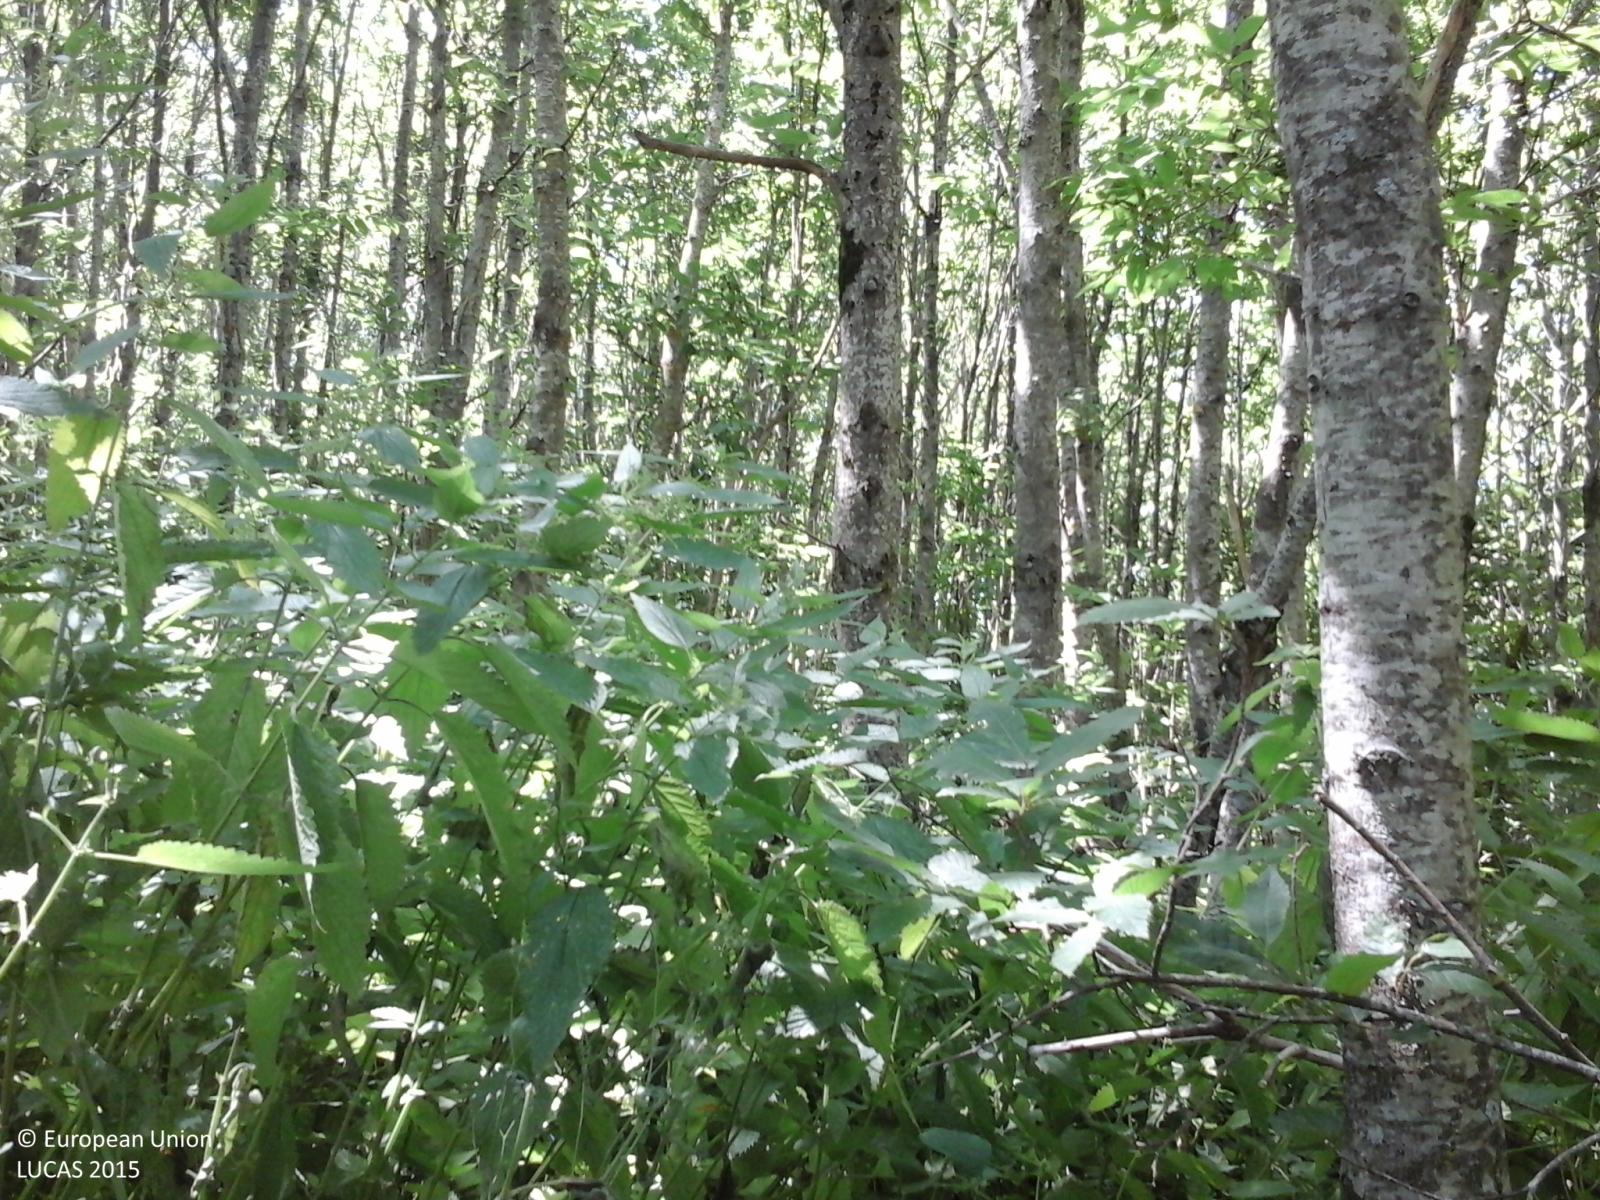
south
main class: Woodland
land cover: Broadleaved woodland
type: thermophilous deciduous forest
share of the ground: > 75 %
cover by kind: broadleaved forest trees 80 %, shrubs 20 %
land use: Forestry
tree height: > 5 m
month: July
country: IT
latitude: 40.8799
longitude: 14.6923
